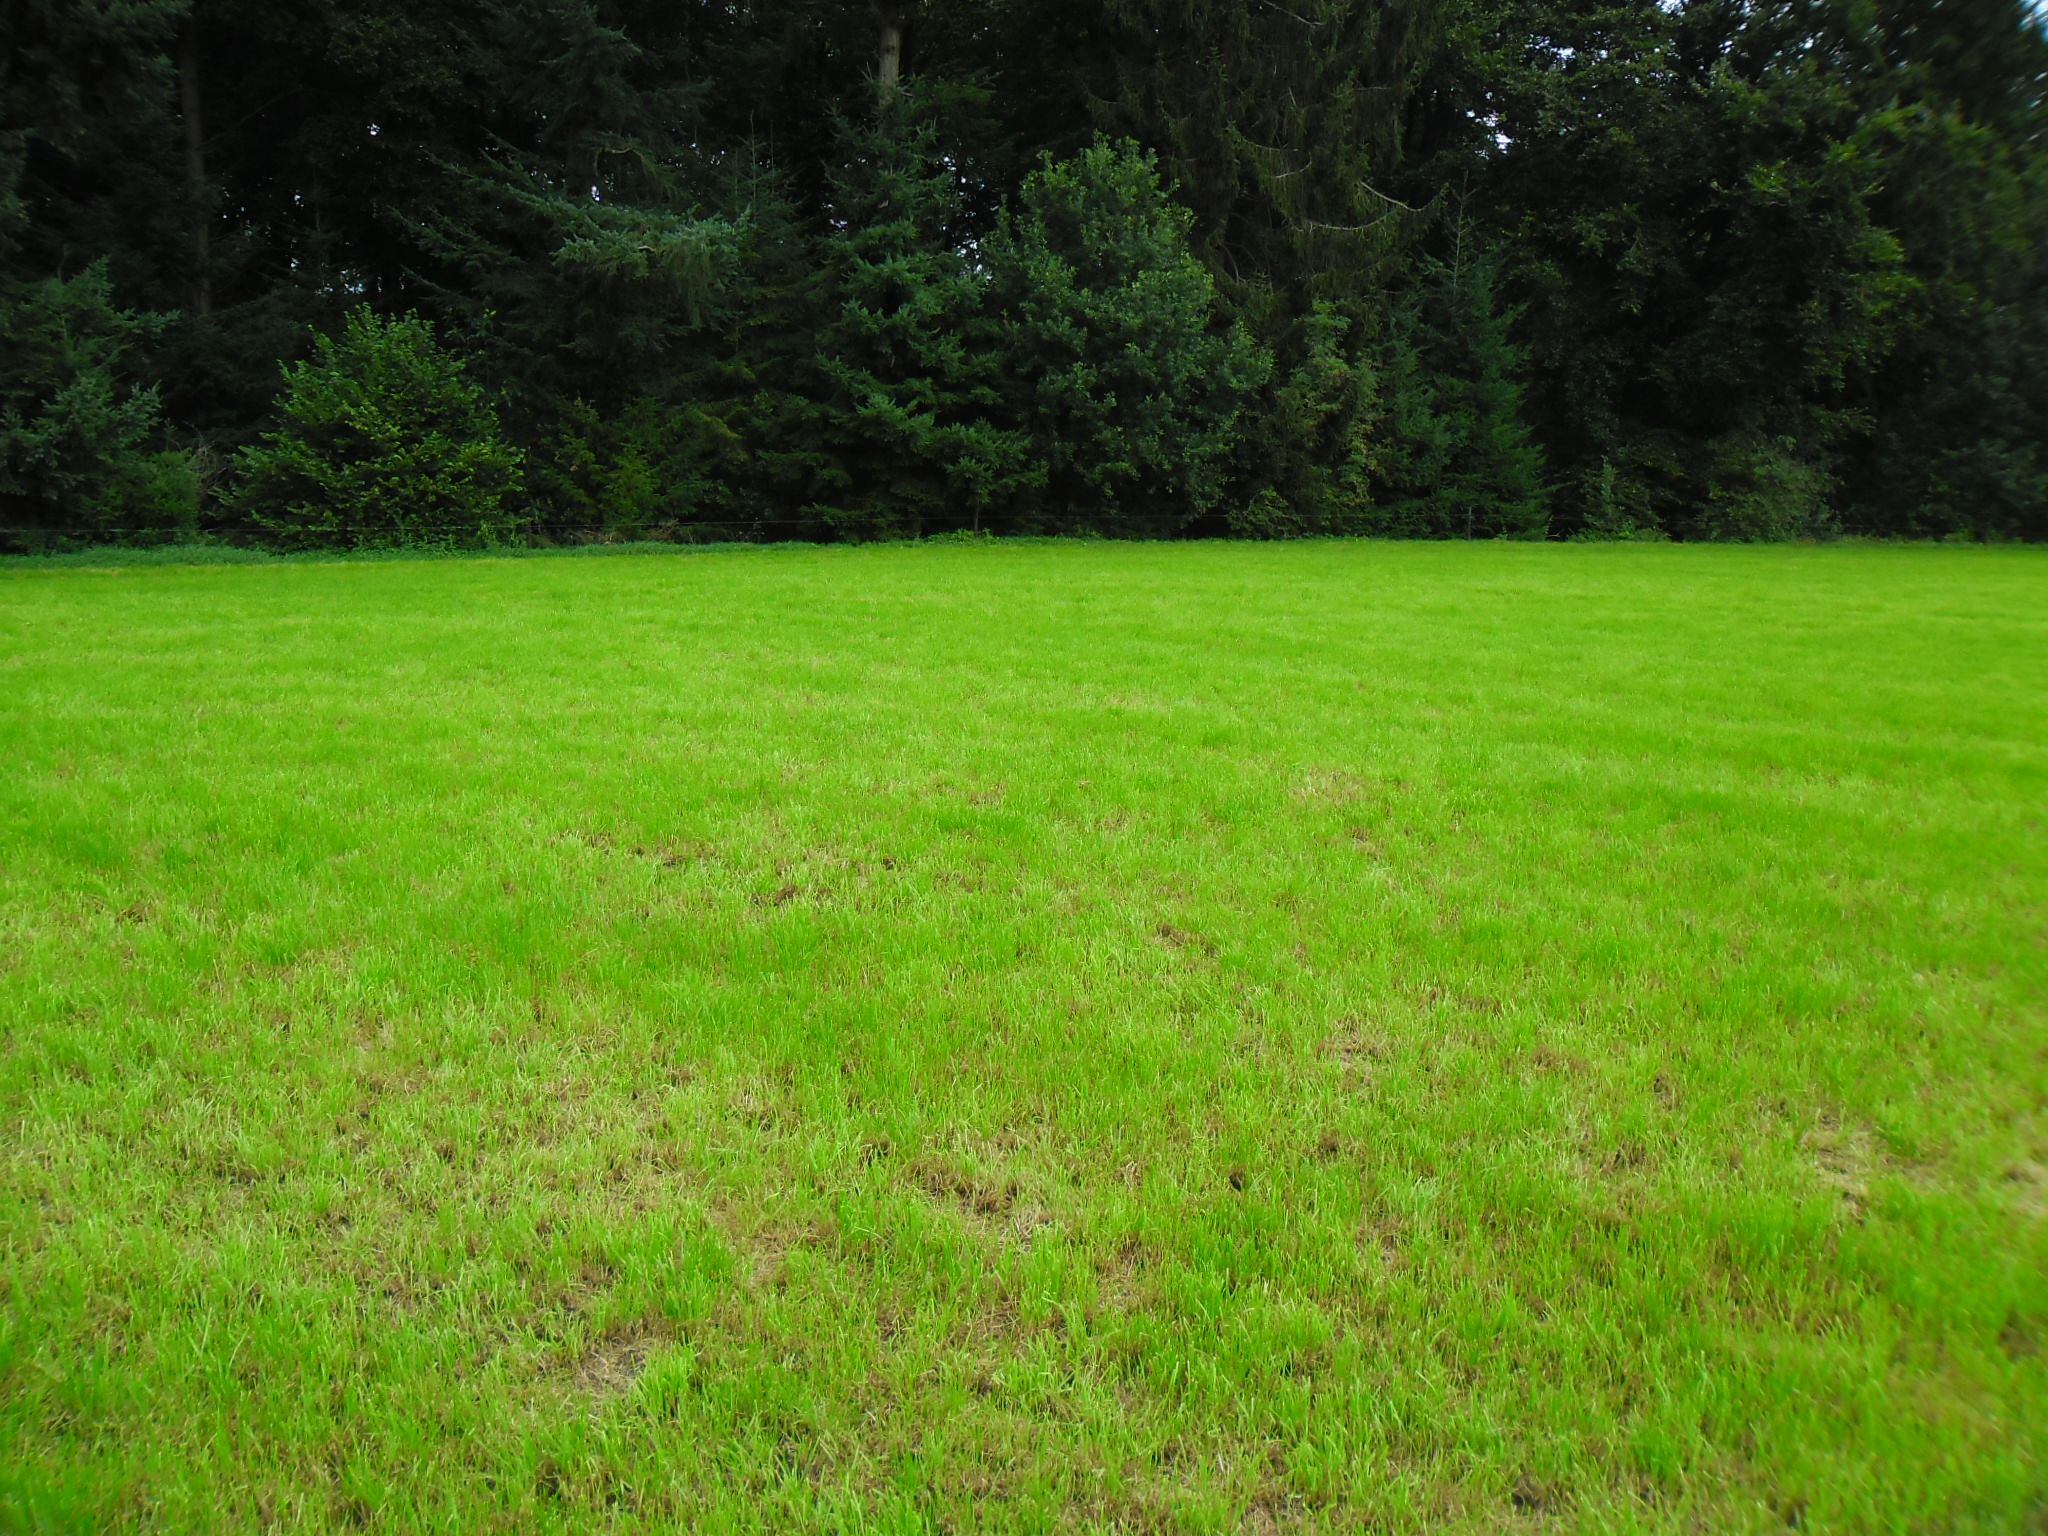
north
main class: Grassland
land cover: Grassland without tree/shrub cover
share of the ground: > 75 %
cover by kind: herbaceous plants 100 %
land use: Agriculture (excluding fallow land and kitchen gardens)
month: September
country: NL
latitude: 52.1570
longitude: 6.2721
